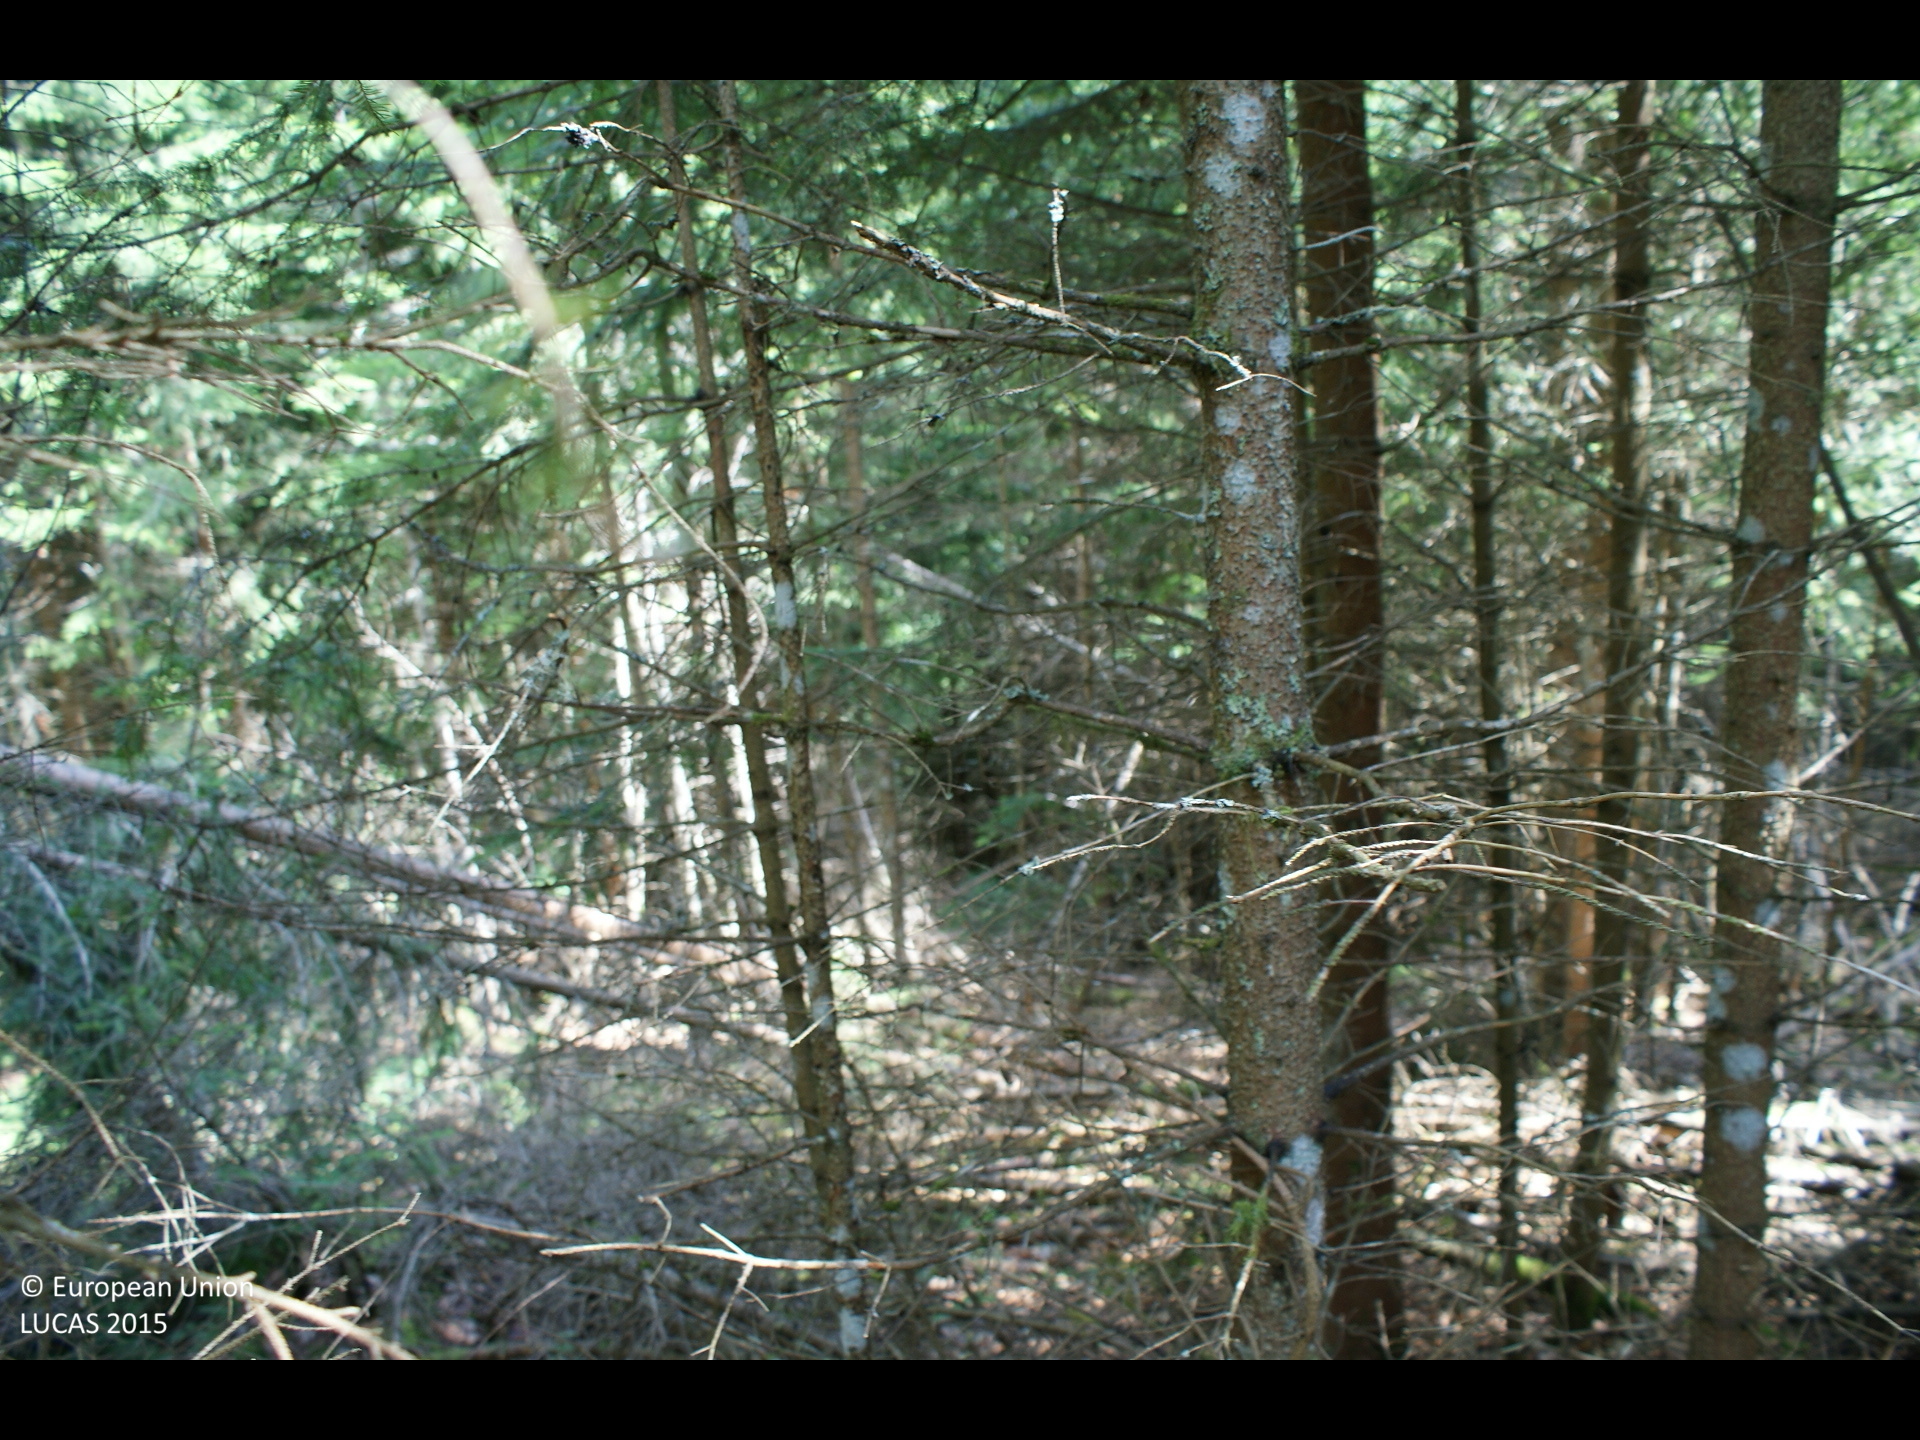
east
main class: Woodland
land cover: Spruce dominated coniferous woodland
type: alpine coniferous forest
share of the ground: > 75 %
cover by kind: coniferous forest trees 80 %, herbaceous plants 15 %, lichens and mosses 5 %
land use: Forestry
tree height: > 5 m
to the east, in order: Spruce dominated coniferous woodland; Other mixed woodland; Rivers and streams; Broadleaved woodland; Spruce dominated mixed woodland; Spruce dominated coniferous woodland; Spruce dominated mixed woodland; Tracks; Spruce dominated mixed woodland; Spruce dominated coniferous woodland
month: August
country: AT
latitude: 47.5690
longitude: 15.3843
